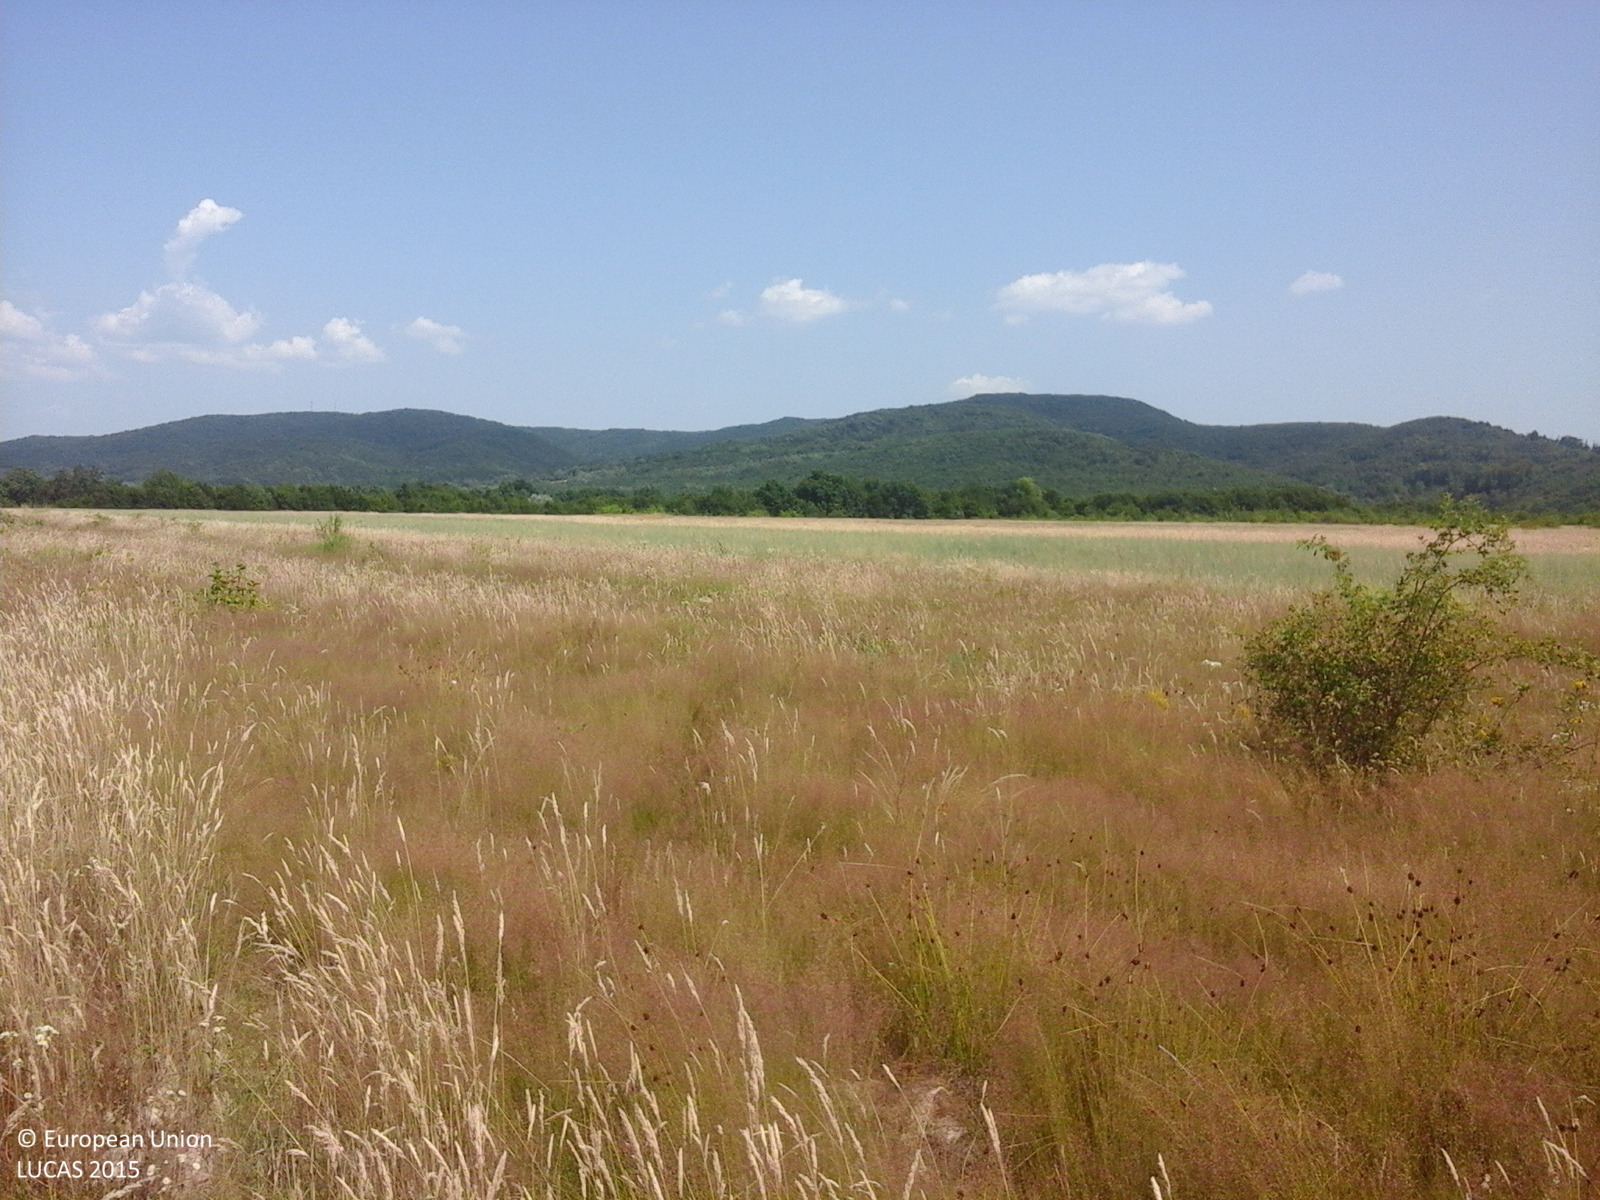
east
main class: Grassland
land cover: Spontaneously vegetated surfaces
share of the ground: > 75 %
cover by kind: herbaceous plants 95 %, shrubs 5 %
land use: Agriculture (excluding fallow land and kitchen gardens)
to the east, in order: Spontaneously vegetated surfaces; Tracks; Spontaneously vegetated surfaces; Oats; Spontaneously vegetated surfaces; Common wheat; Spontaneously vegetated surfaces; Oats; Spontaneously vegetated surfaces
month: July
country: RO
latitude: 45.0298
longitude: 24.3518
